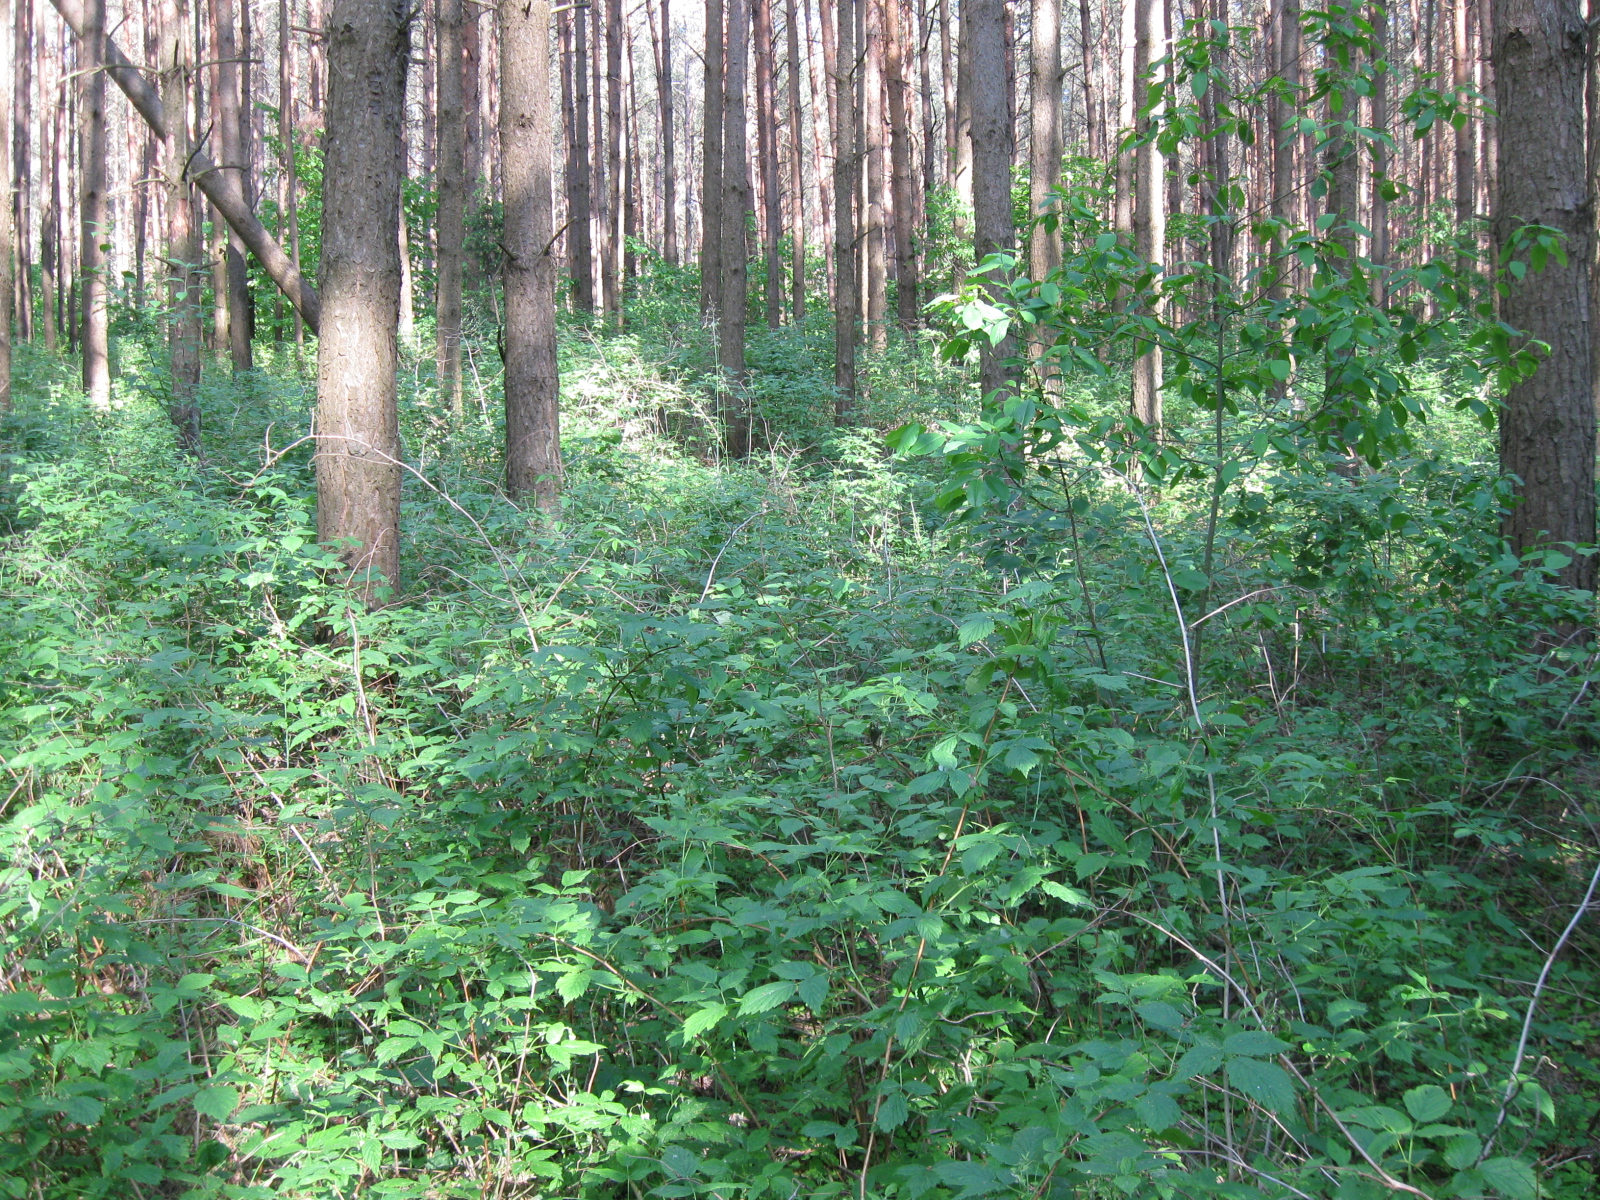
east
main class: Woodland
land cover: Pine dominated coniferous woodland
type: hemiboreal forest and nemoral coniferous forest and mixed broadleaved-coniferous forest
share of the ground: > 75 %
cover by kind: coniferous forest trees 90 %, broadleaved forest trees 5 %, herbaceous plants 5 %
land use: Forestry
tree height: > 5 m
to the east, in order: Pine dominated coniferous woodland; Electric lines; Pine dominated mixed woodland; Tracks; Pine dominated mixed woodland; Pine dominated coniferous woodland
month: June
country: LT
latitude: 54.2750
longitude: 23.7396
